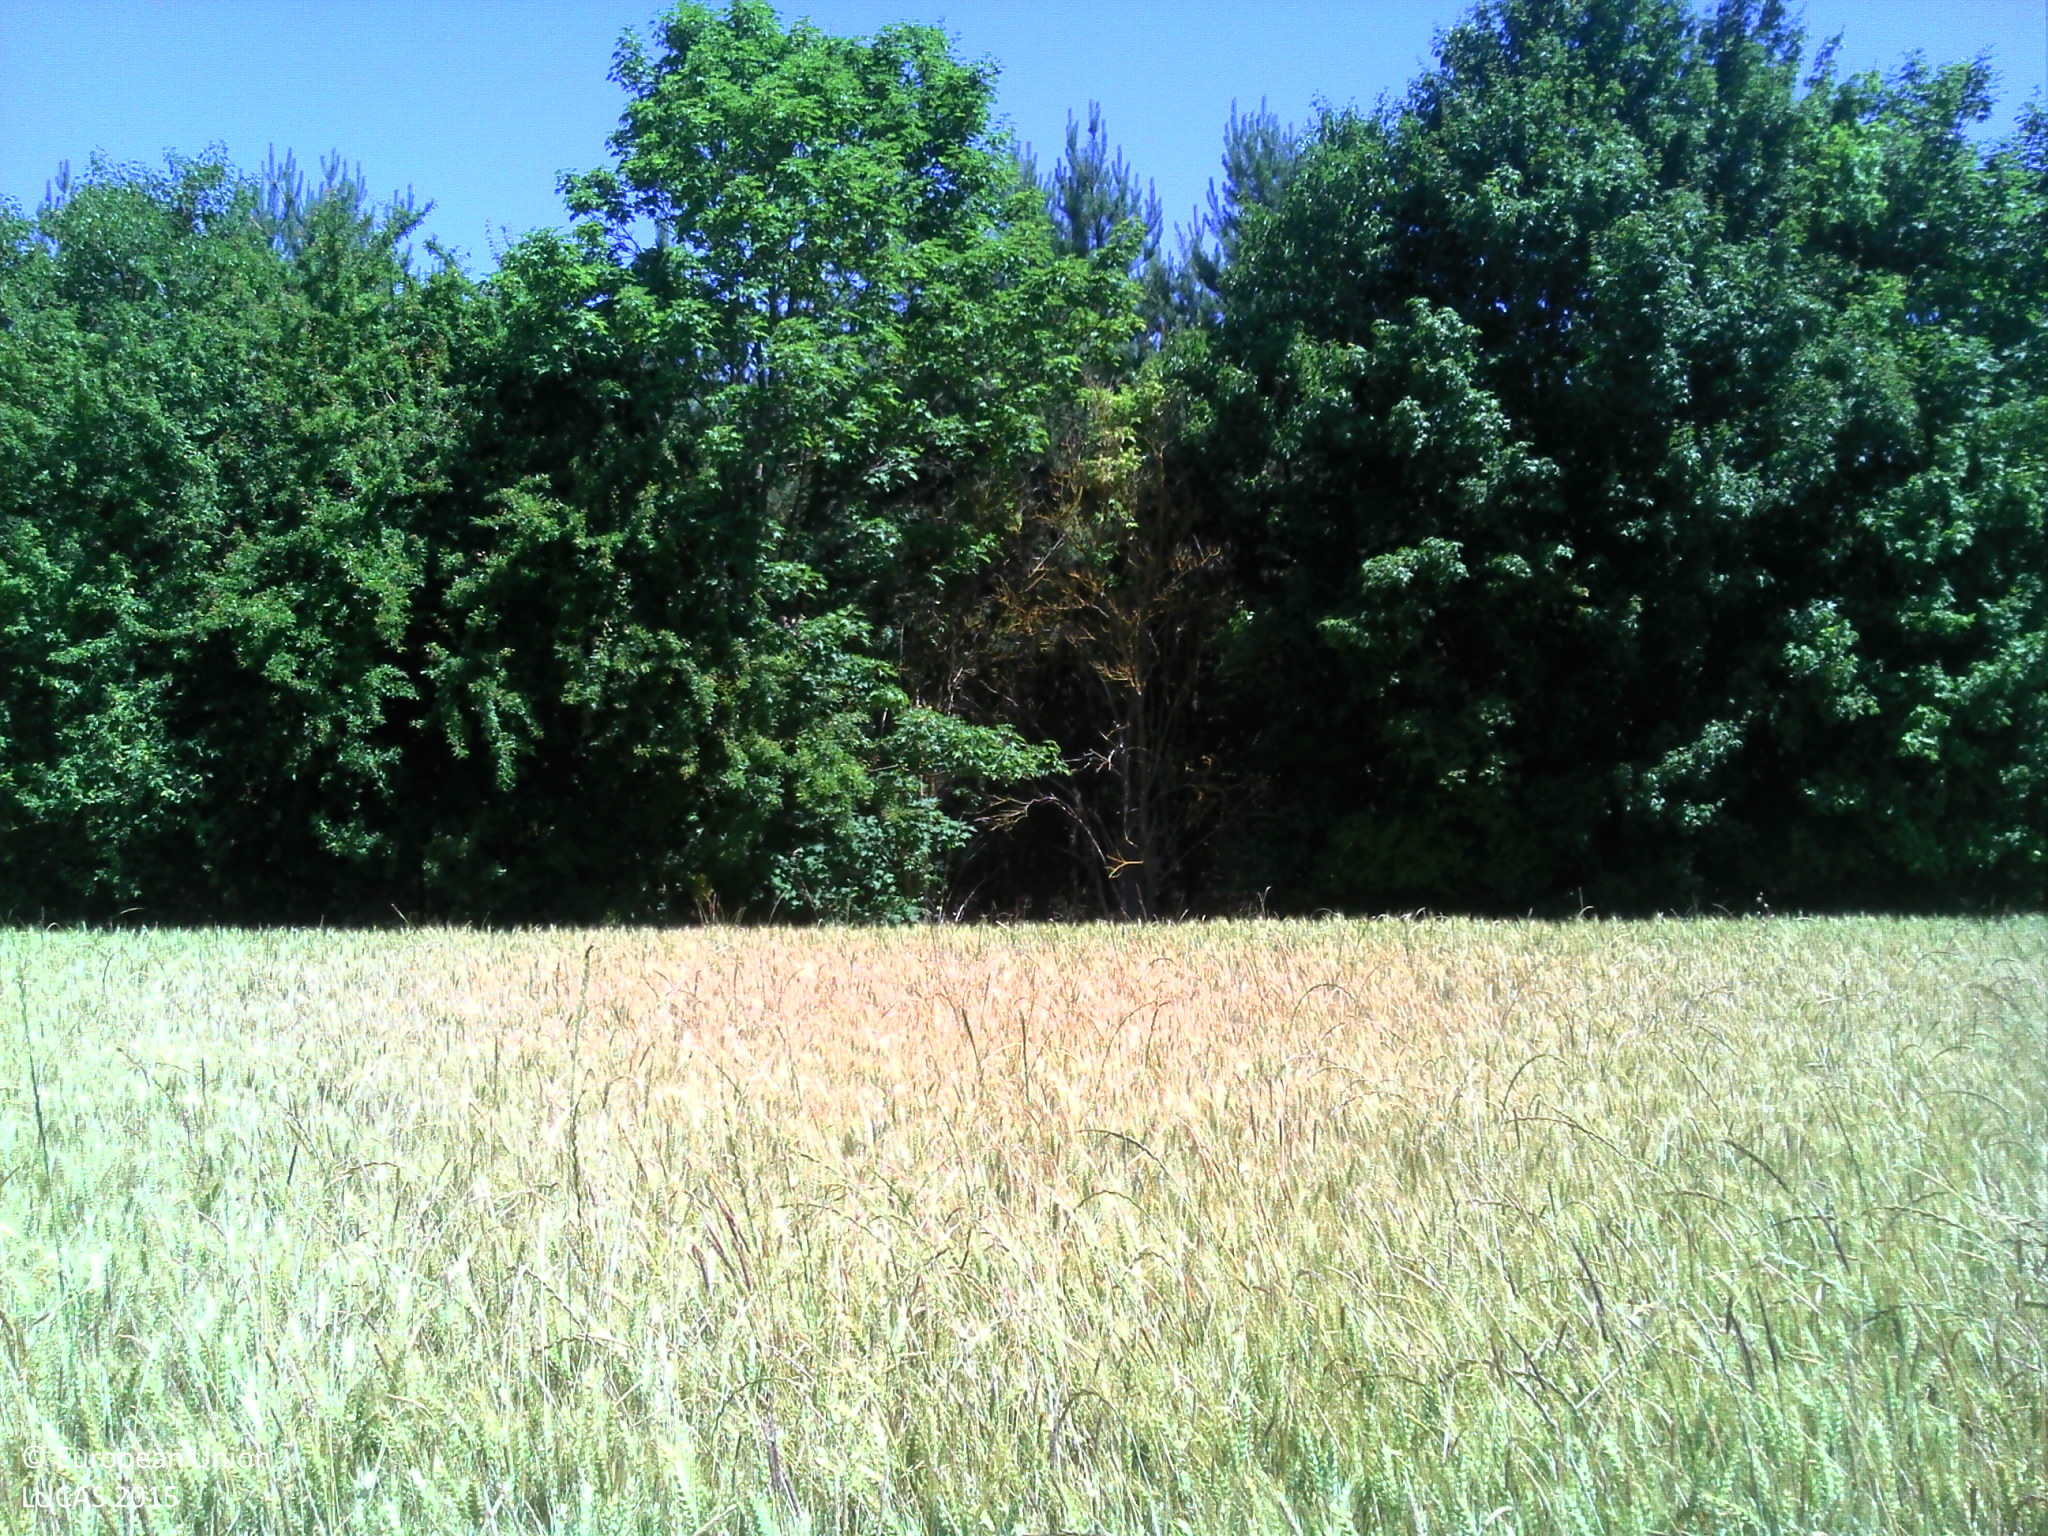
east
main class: Cropland
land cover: Common wheat
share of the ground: > 75 %
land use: Agriculture (excluding fallow land and kitchen gardens)
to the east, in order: Common wheat; Spruce dominated coniferous woodland; Grassland without tree/shrub cover; Single bushes/trees
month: June
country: FR
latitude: 49.0395
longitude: 1.1010
